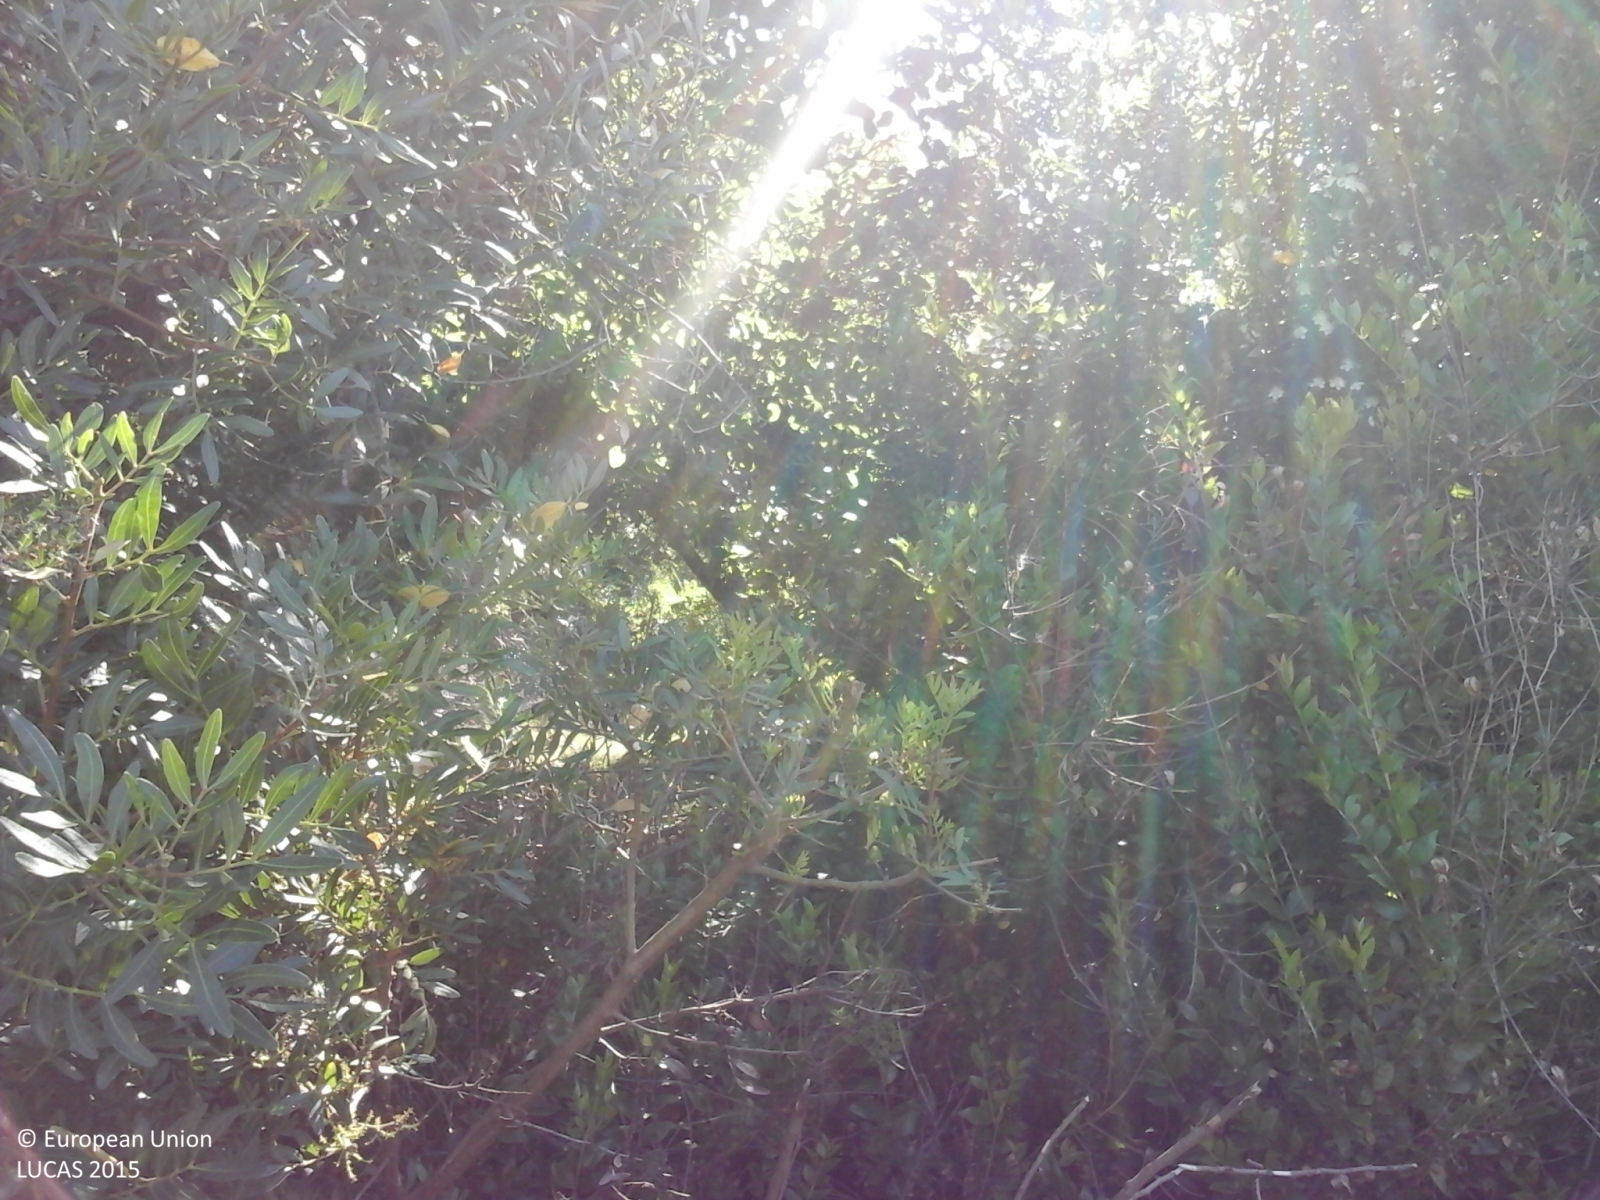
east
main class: Cropland
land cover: Olive groves
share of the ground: > 75 %
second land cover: Spontaneously vegetated surfaces
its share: > 75 %
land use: Kitchen garden
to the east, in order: Olive groves; Spontaneously vegetated surfaces; Electric lines; Dry stone walls; Shrubland with sparse tree cover; Olive groves; Other fresh vegetables; Other fruit trees and berries; Tracks; Spontaneously vegetated surfaces; Artificial constructions in urban areas; Broadleaved woodland; Paved roads, cycling and walking lanes; Dry stone walls; Shrubland with sparse tree cover; Permanent crops (only in case pi); Broadleaved woodland; Tracks; Broadleaved woodland
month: June
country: IT
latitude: 40.3715
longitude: 15.0775
